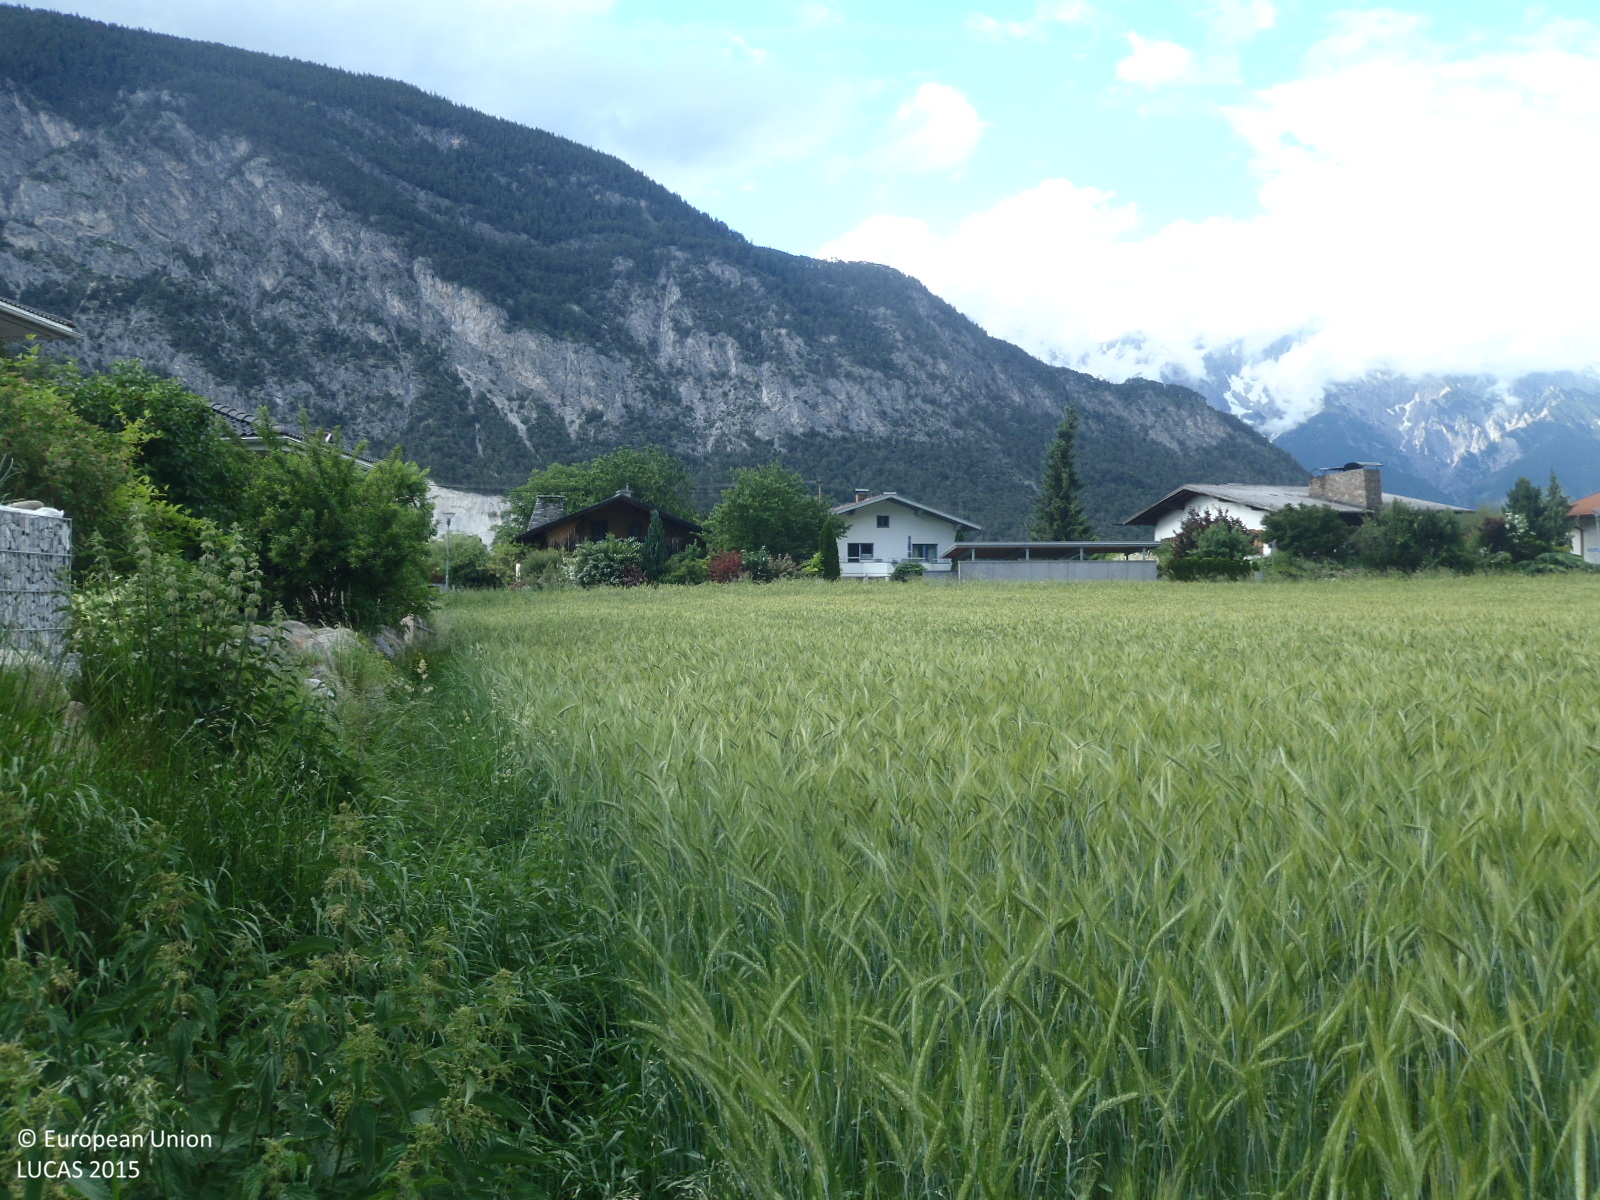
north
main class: Cropland
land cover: Rye
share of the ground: > 75 %
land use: Agriculture (excluding fallow land and kitchen gardens)
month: June
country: AT
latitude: 47.2655
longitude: 10.9375
